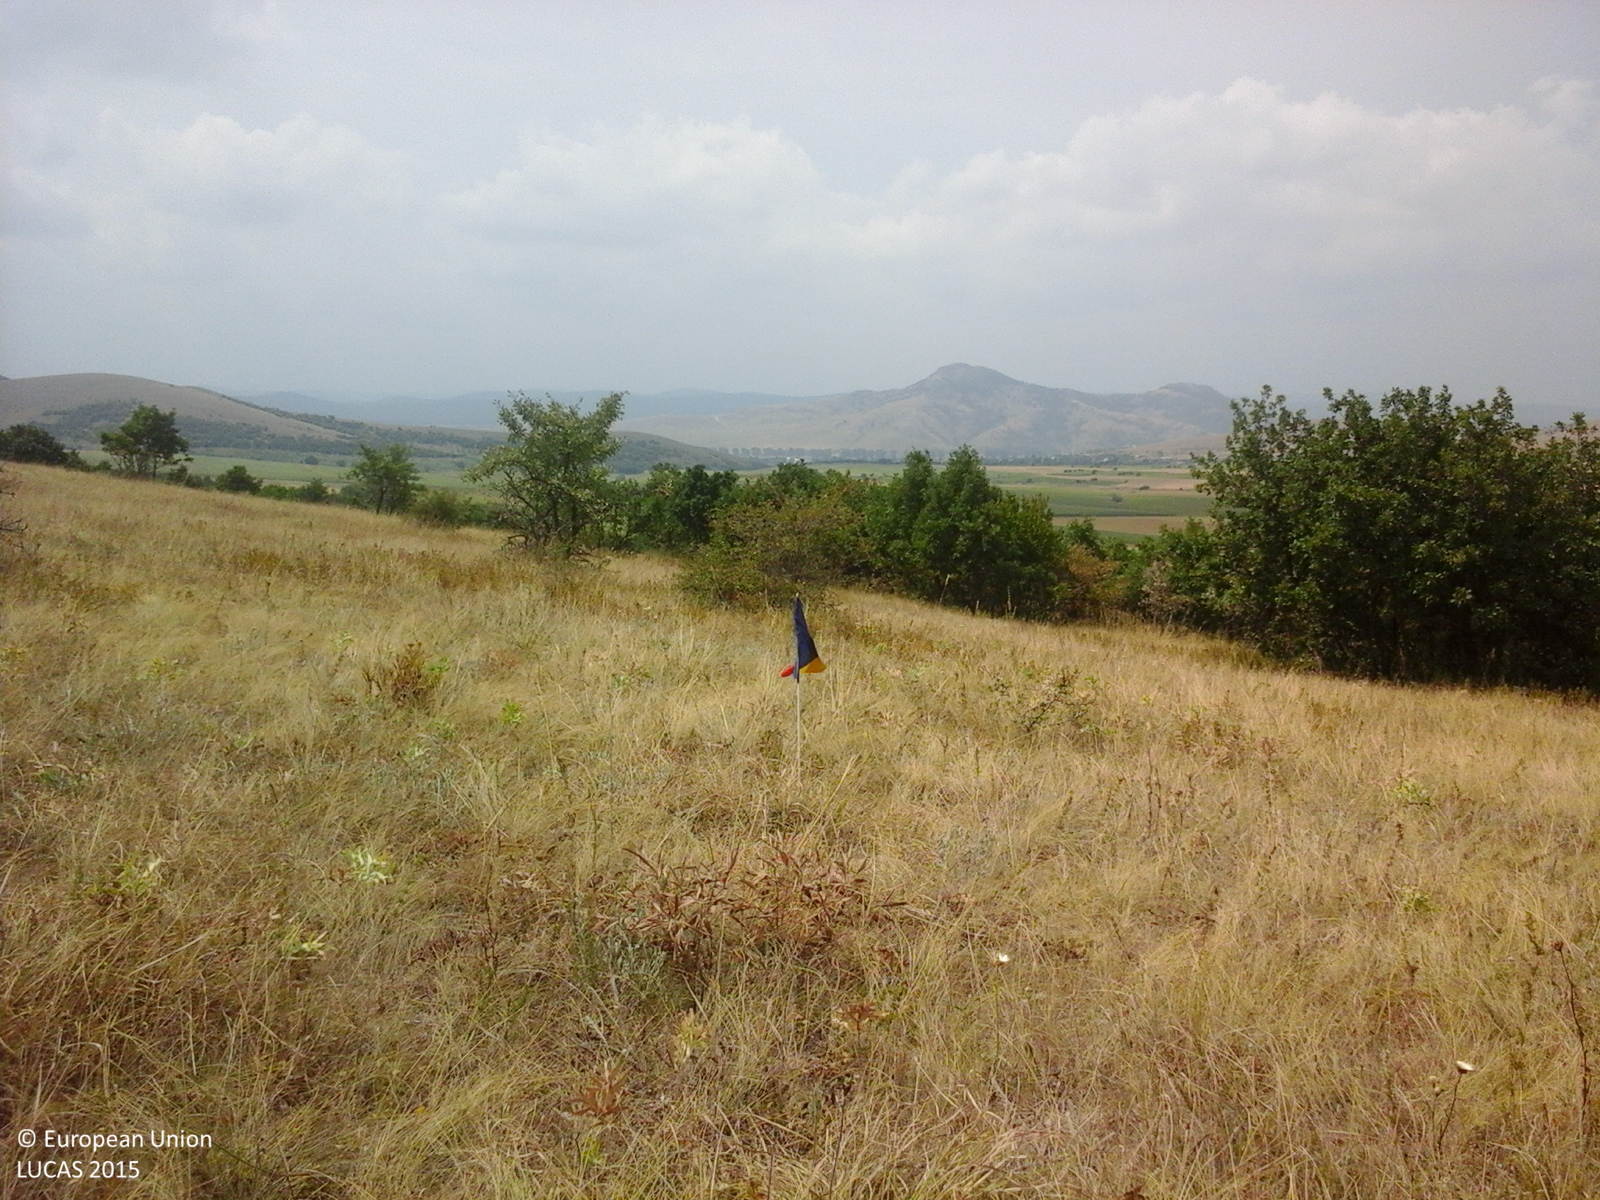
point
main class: Grassland
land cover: Grassland with sparse tree/shrub cover
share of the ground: > 75 %
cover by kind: herbaceous plants 85 %, shrubs 10 %, broadleaved forest trees 5 %
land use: Agriculture (excluding fallow land and kitchen gardens)
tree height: < 5 m
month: July
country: RO
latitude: 45.0594
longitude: 28.5576
